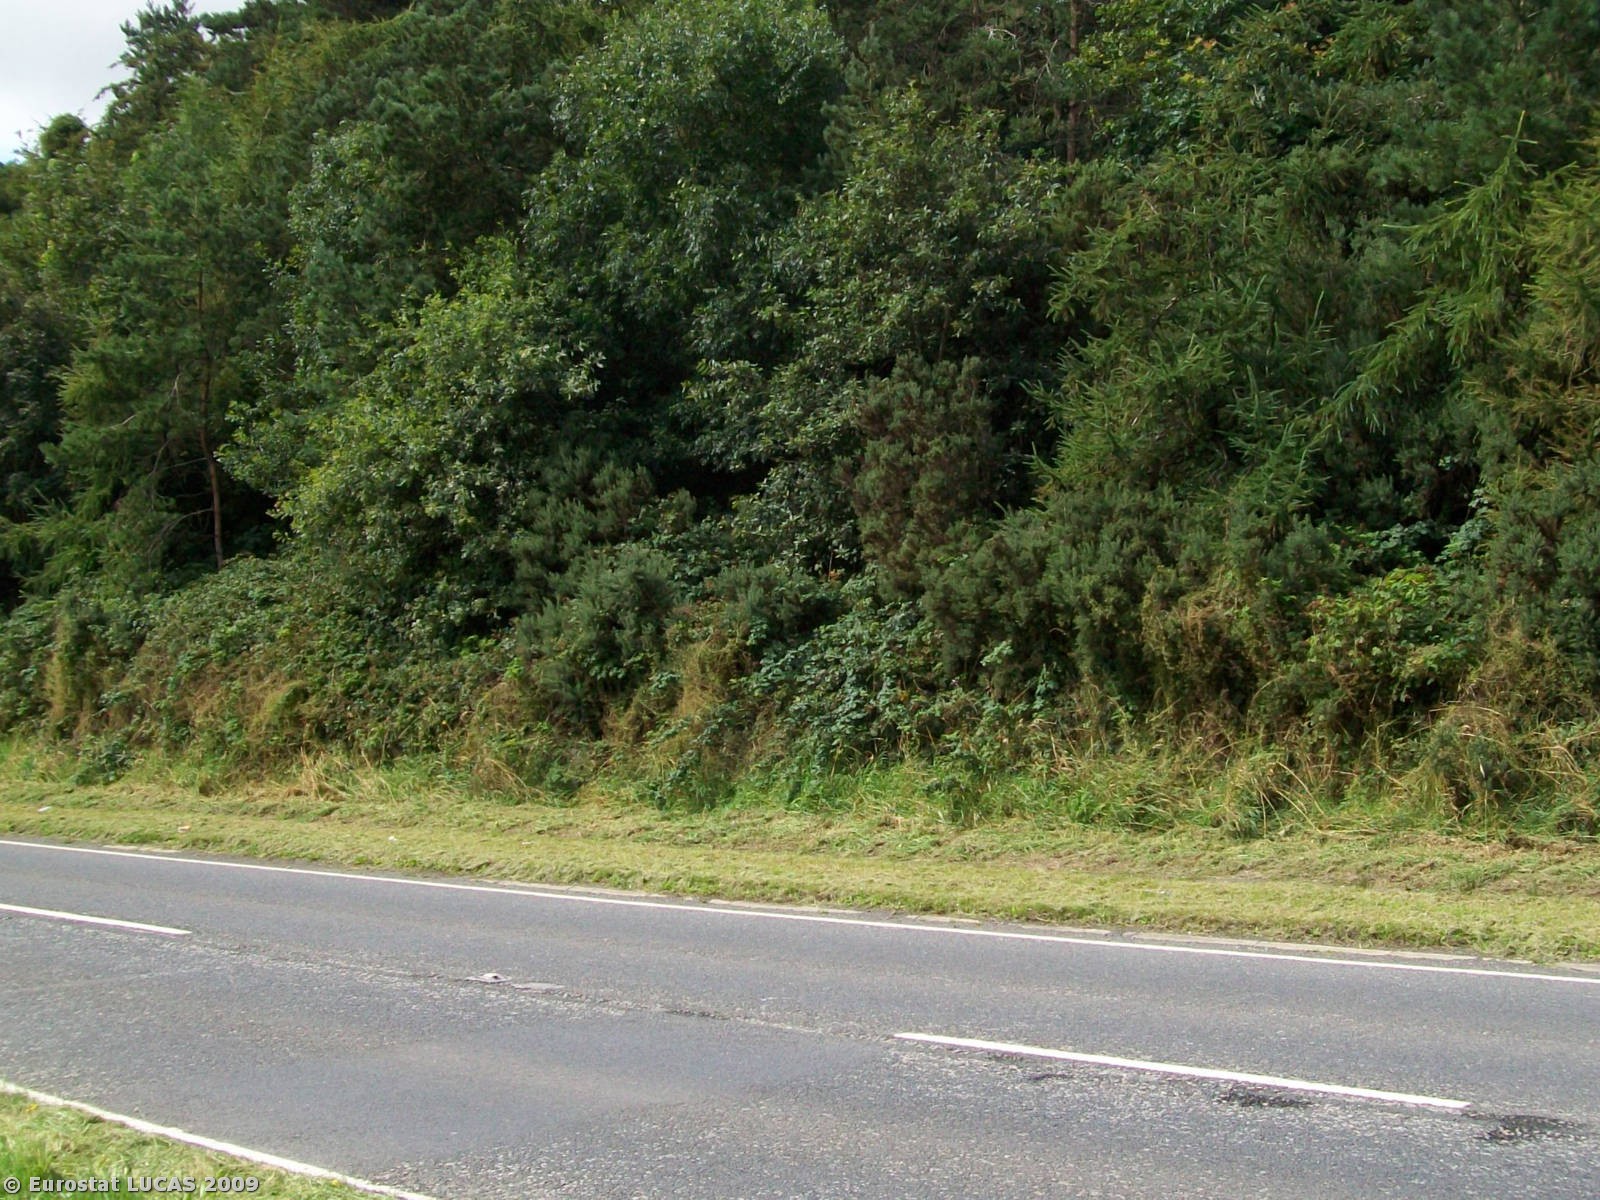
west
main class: Artificial land
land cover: Non built-up linear features
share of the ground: > 75 %
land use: Road transport
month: August
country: GB
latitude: 54.3901
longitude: -5.6708
